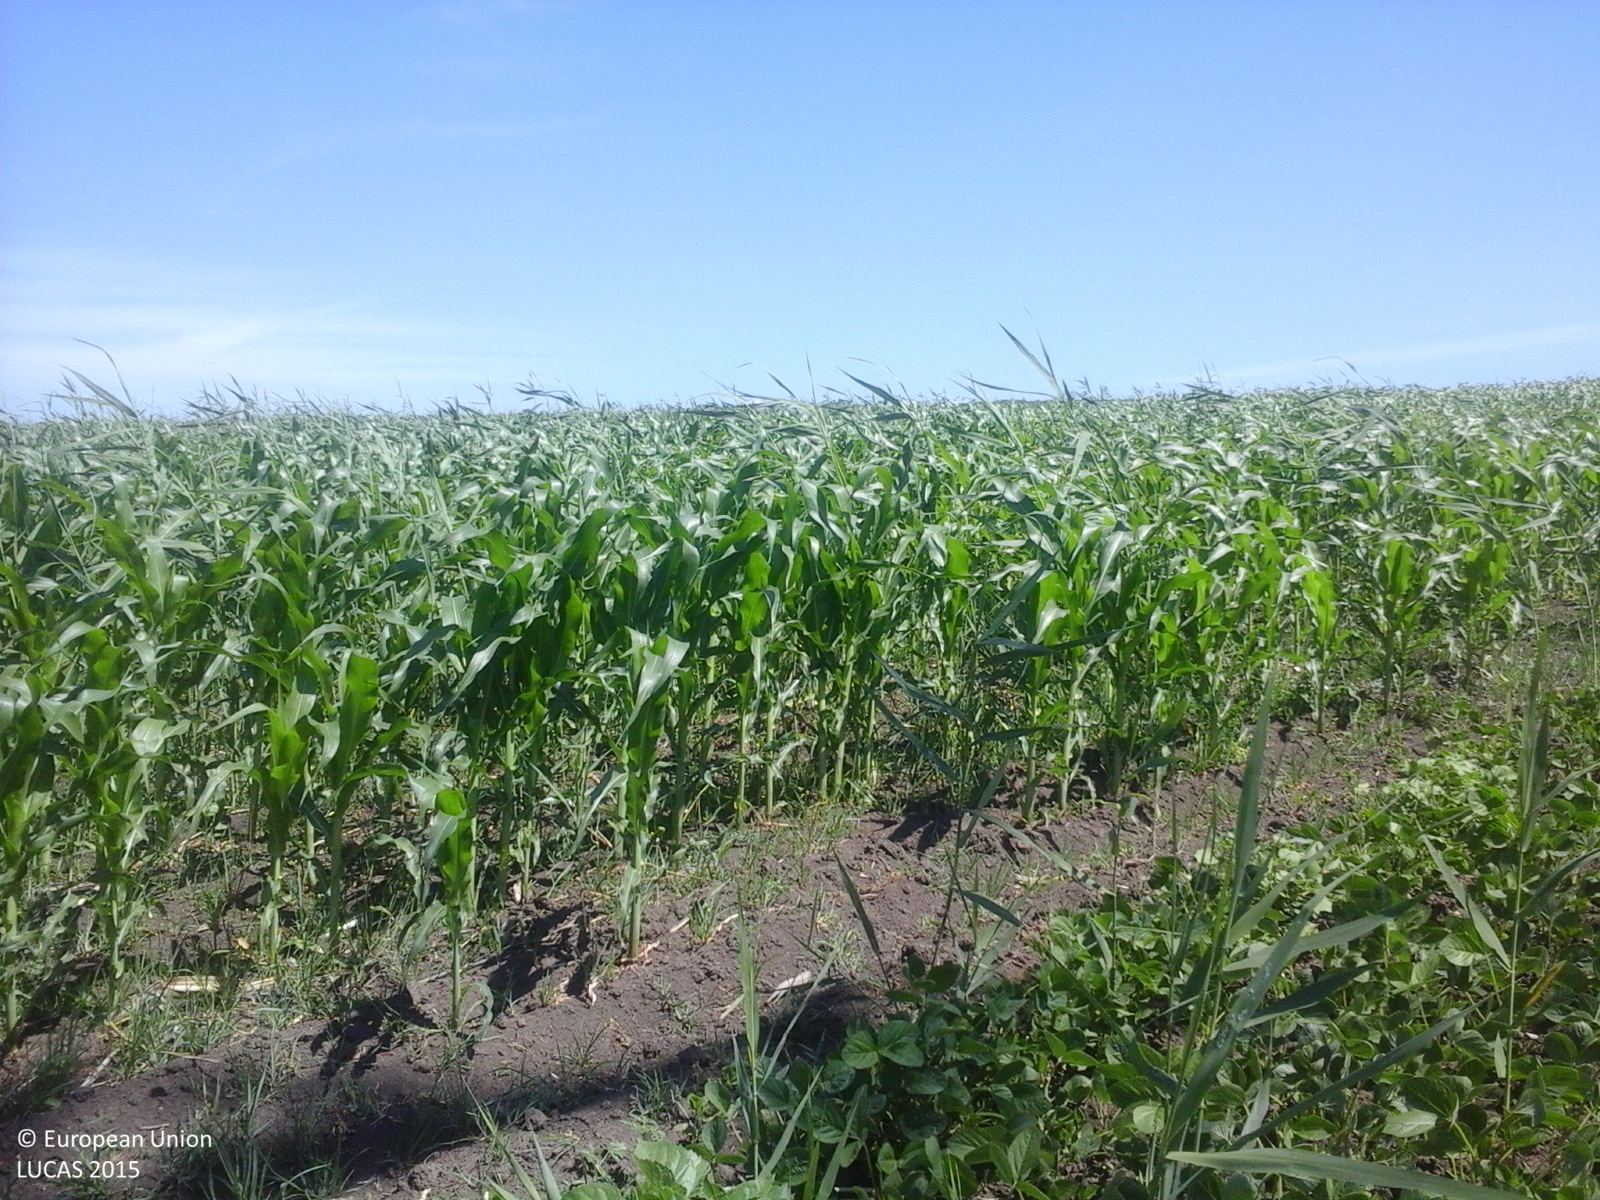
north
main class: Cropland
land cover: Soya
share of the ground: > 75 %
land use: Agriculture (excluding fallow land and kitchen gardens)
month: June
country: RO
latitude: 47.7841
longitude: 27.0439
